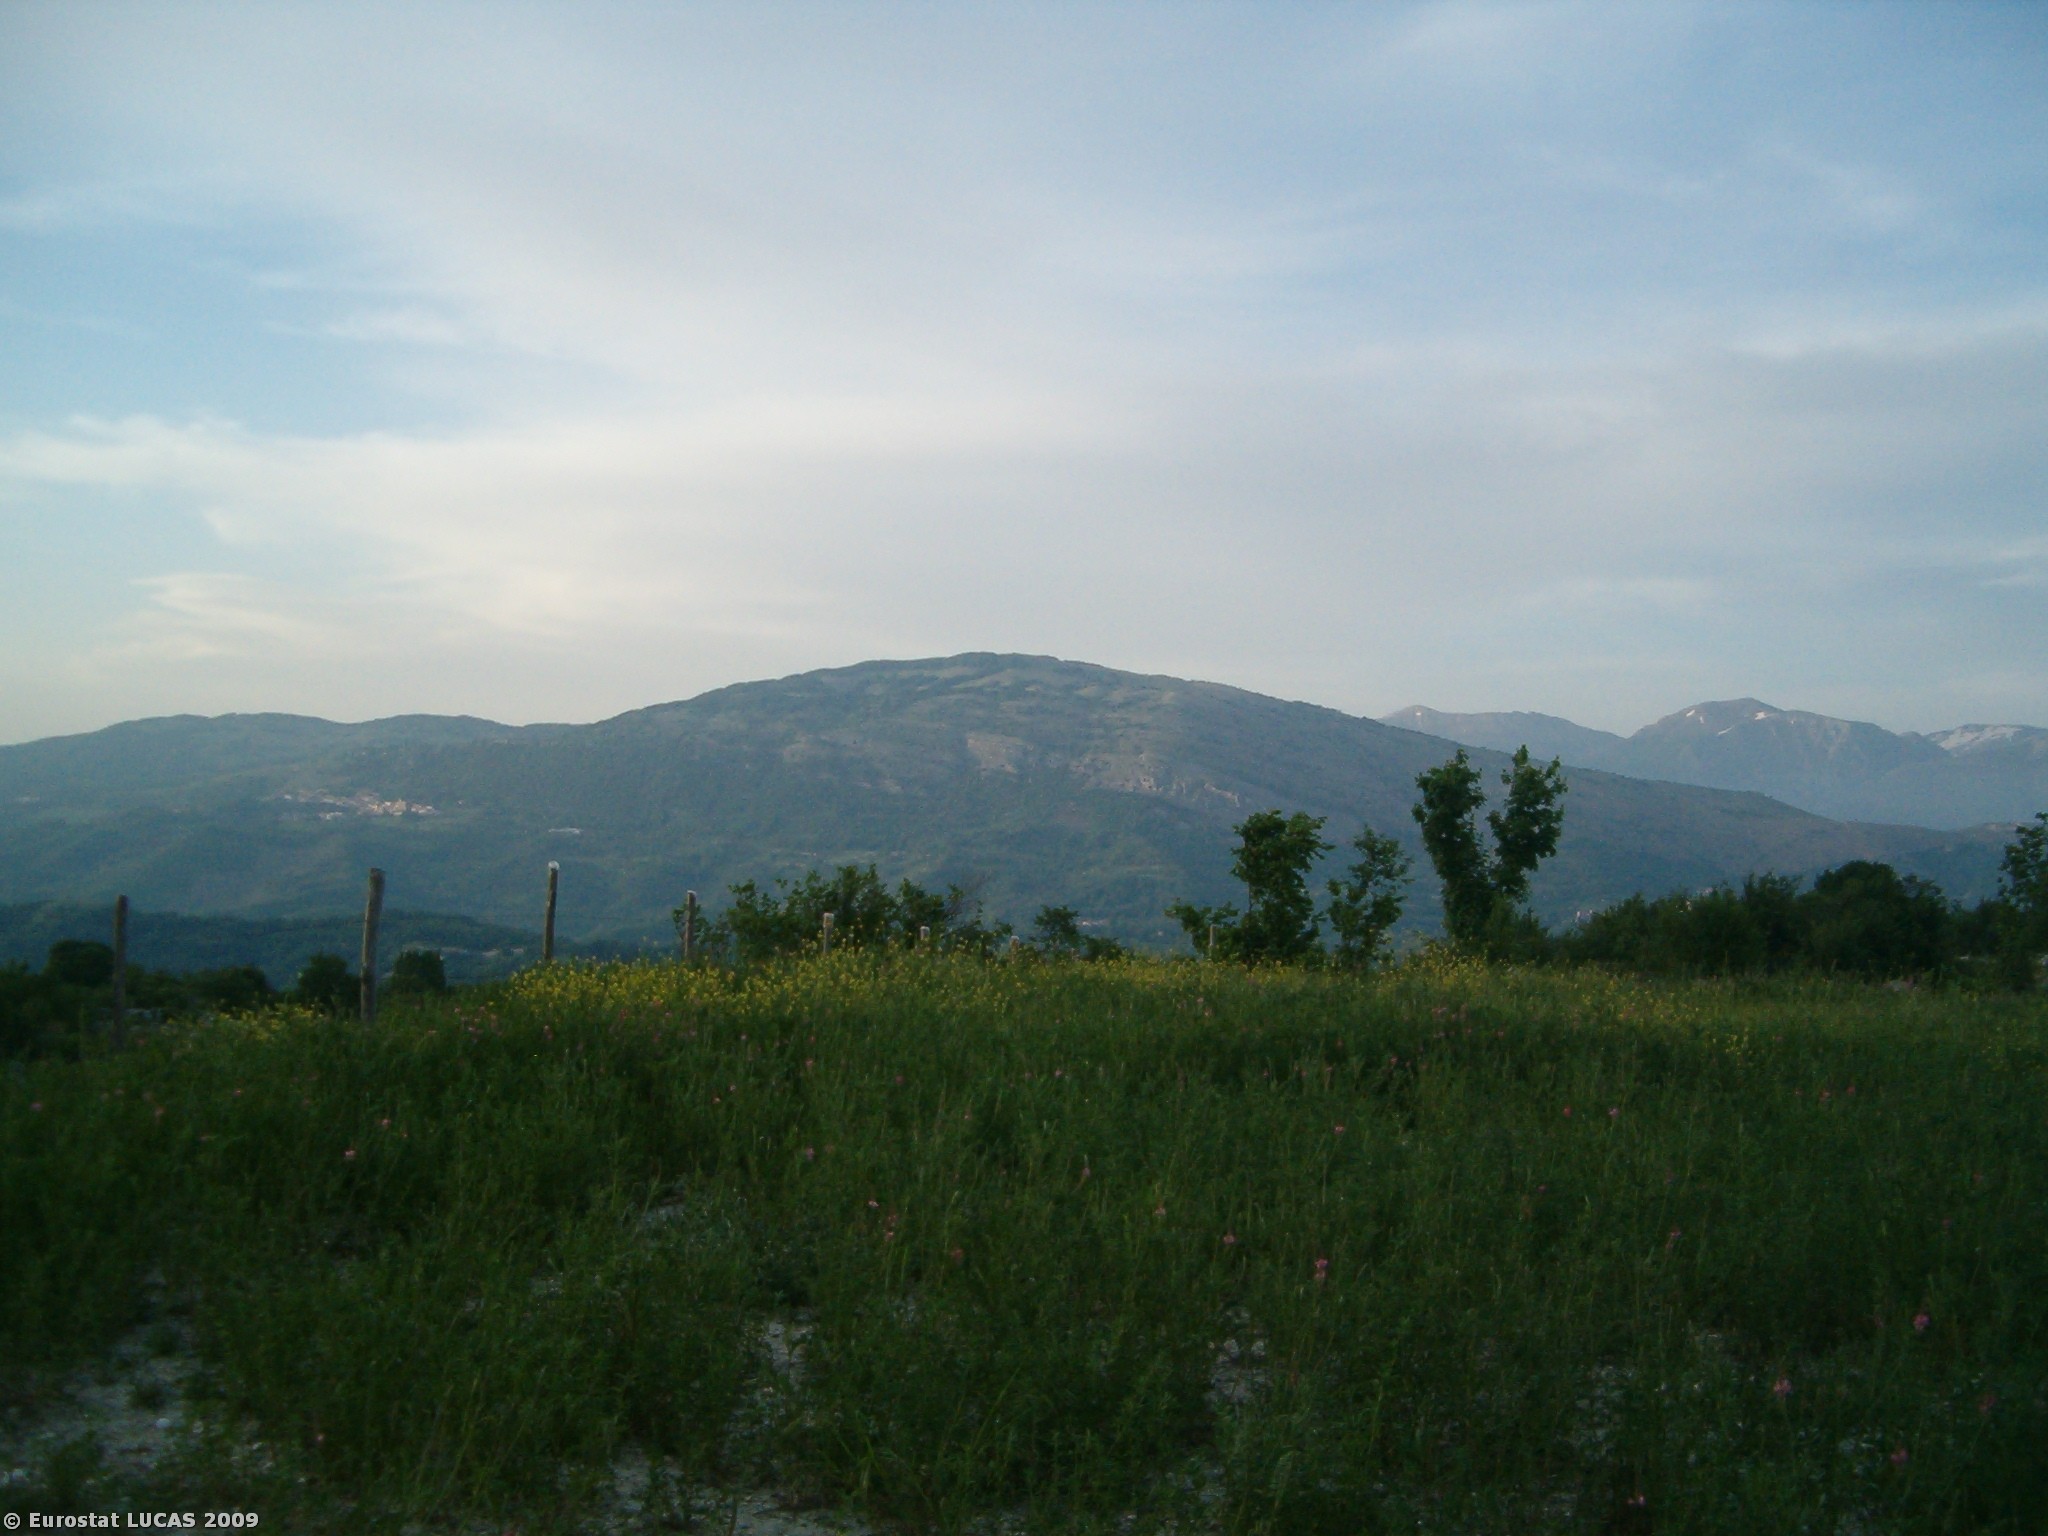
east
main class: Grassland
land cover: Grassland without tree/shrub cover
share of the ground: > 75 %
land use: Agriculture (excluding fallow land and kitchen gardens)
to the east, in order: Grassland without tree/shrub cover; Fences; Grassland without tree/shrub cover; Shrubland with sparse tree cover
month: May
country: IT
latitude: 42.0787
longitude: 13.2163
